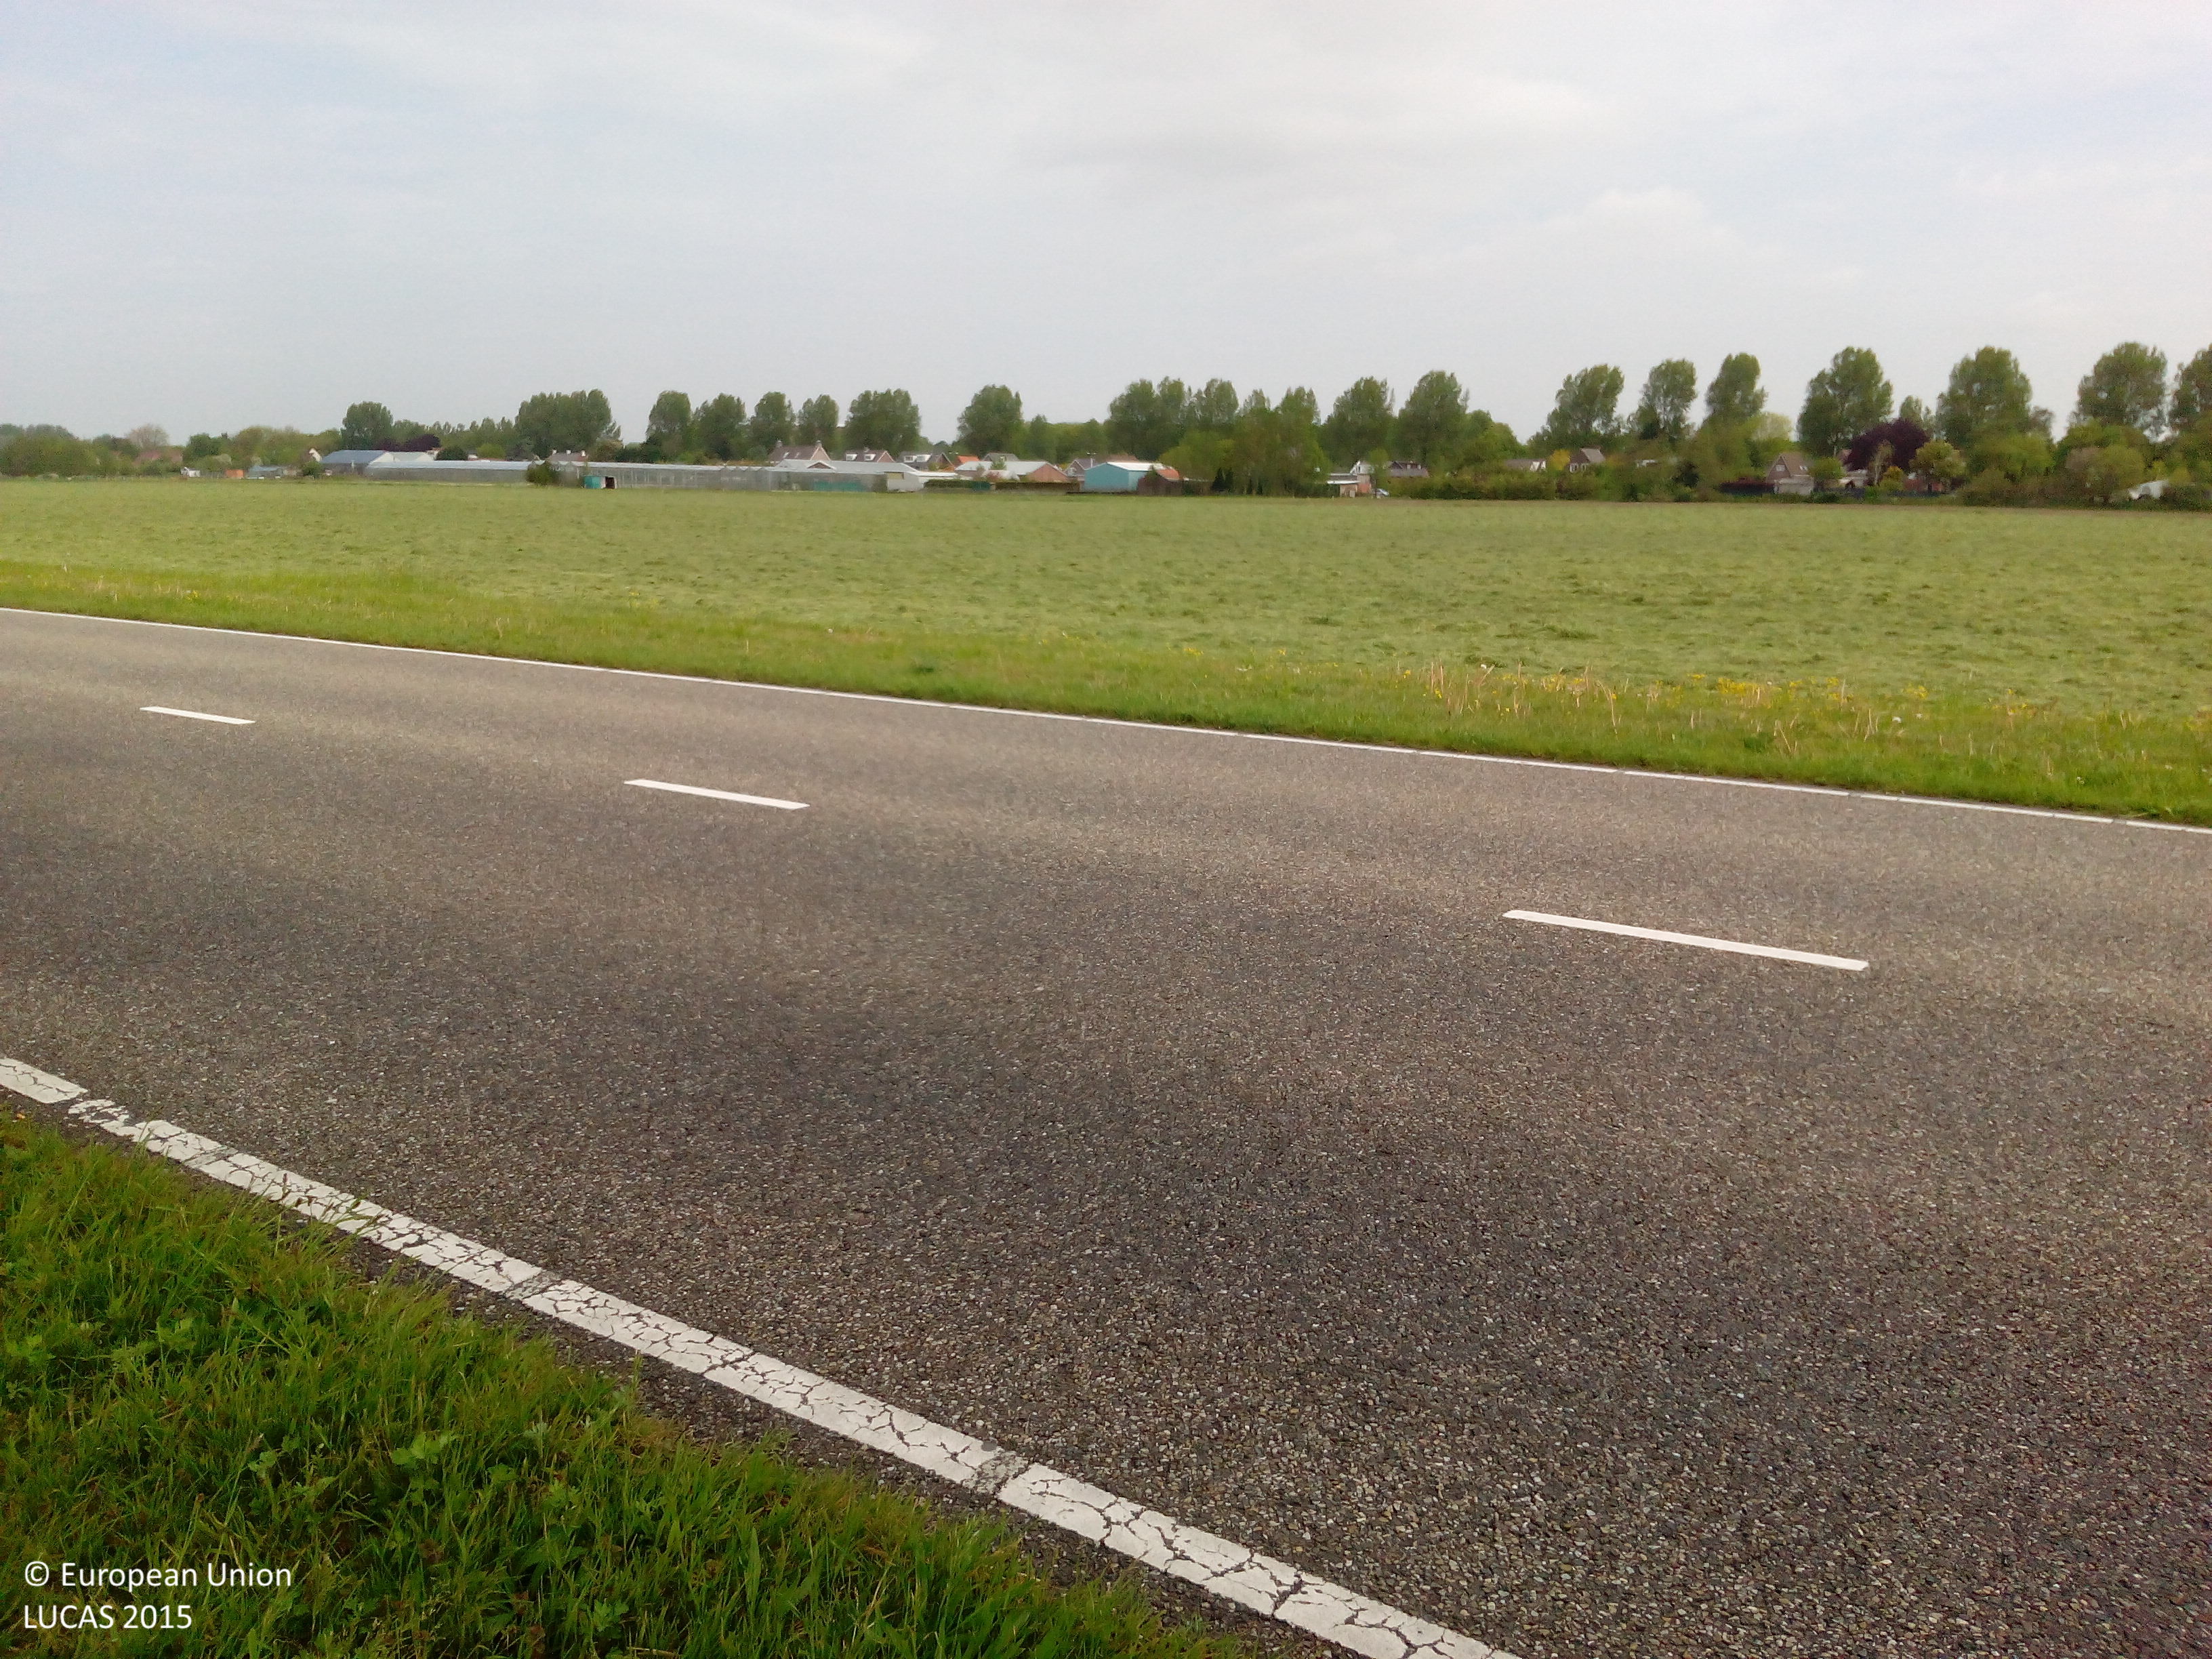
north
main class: Cropland
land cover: Temporary grasslands
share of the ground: 10 - 25 %
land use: Agriculture (excluding fallow land and kitchen gardens)
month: May
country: NL
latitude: 52.3285
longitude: 4.6405
